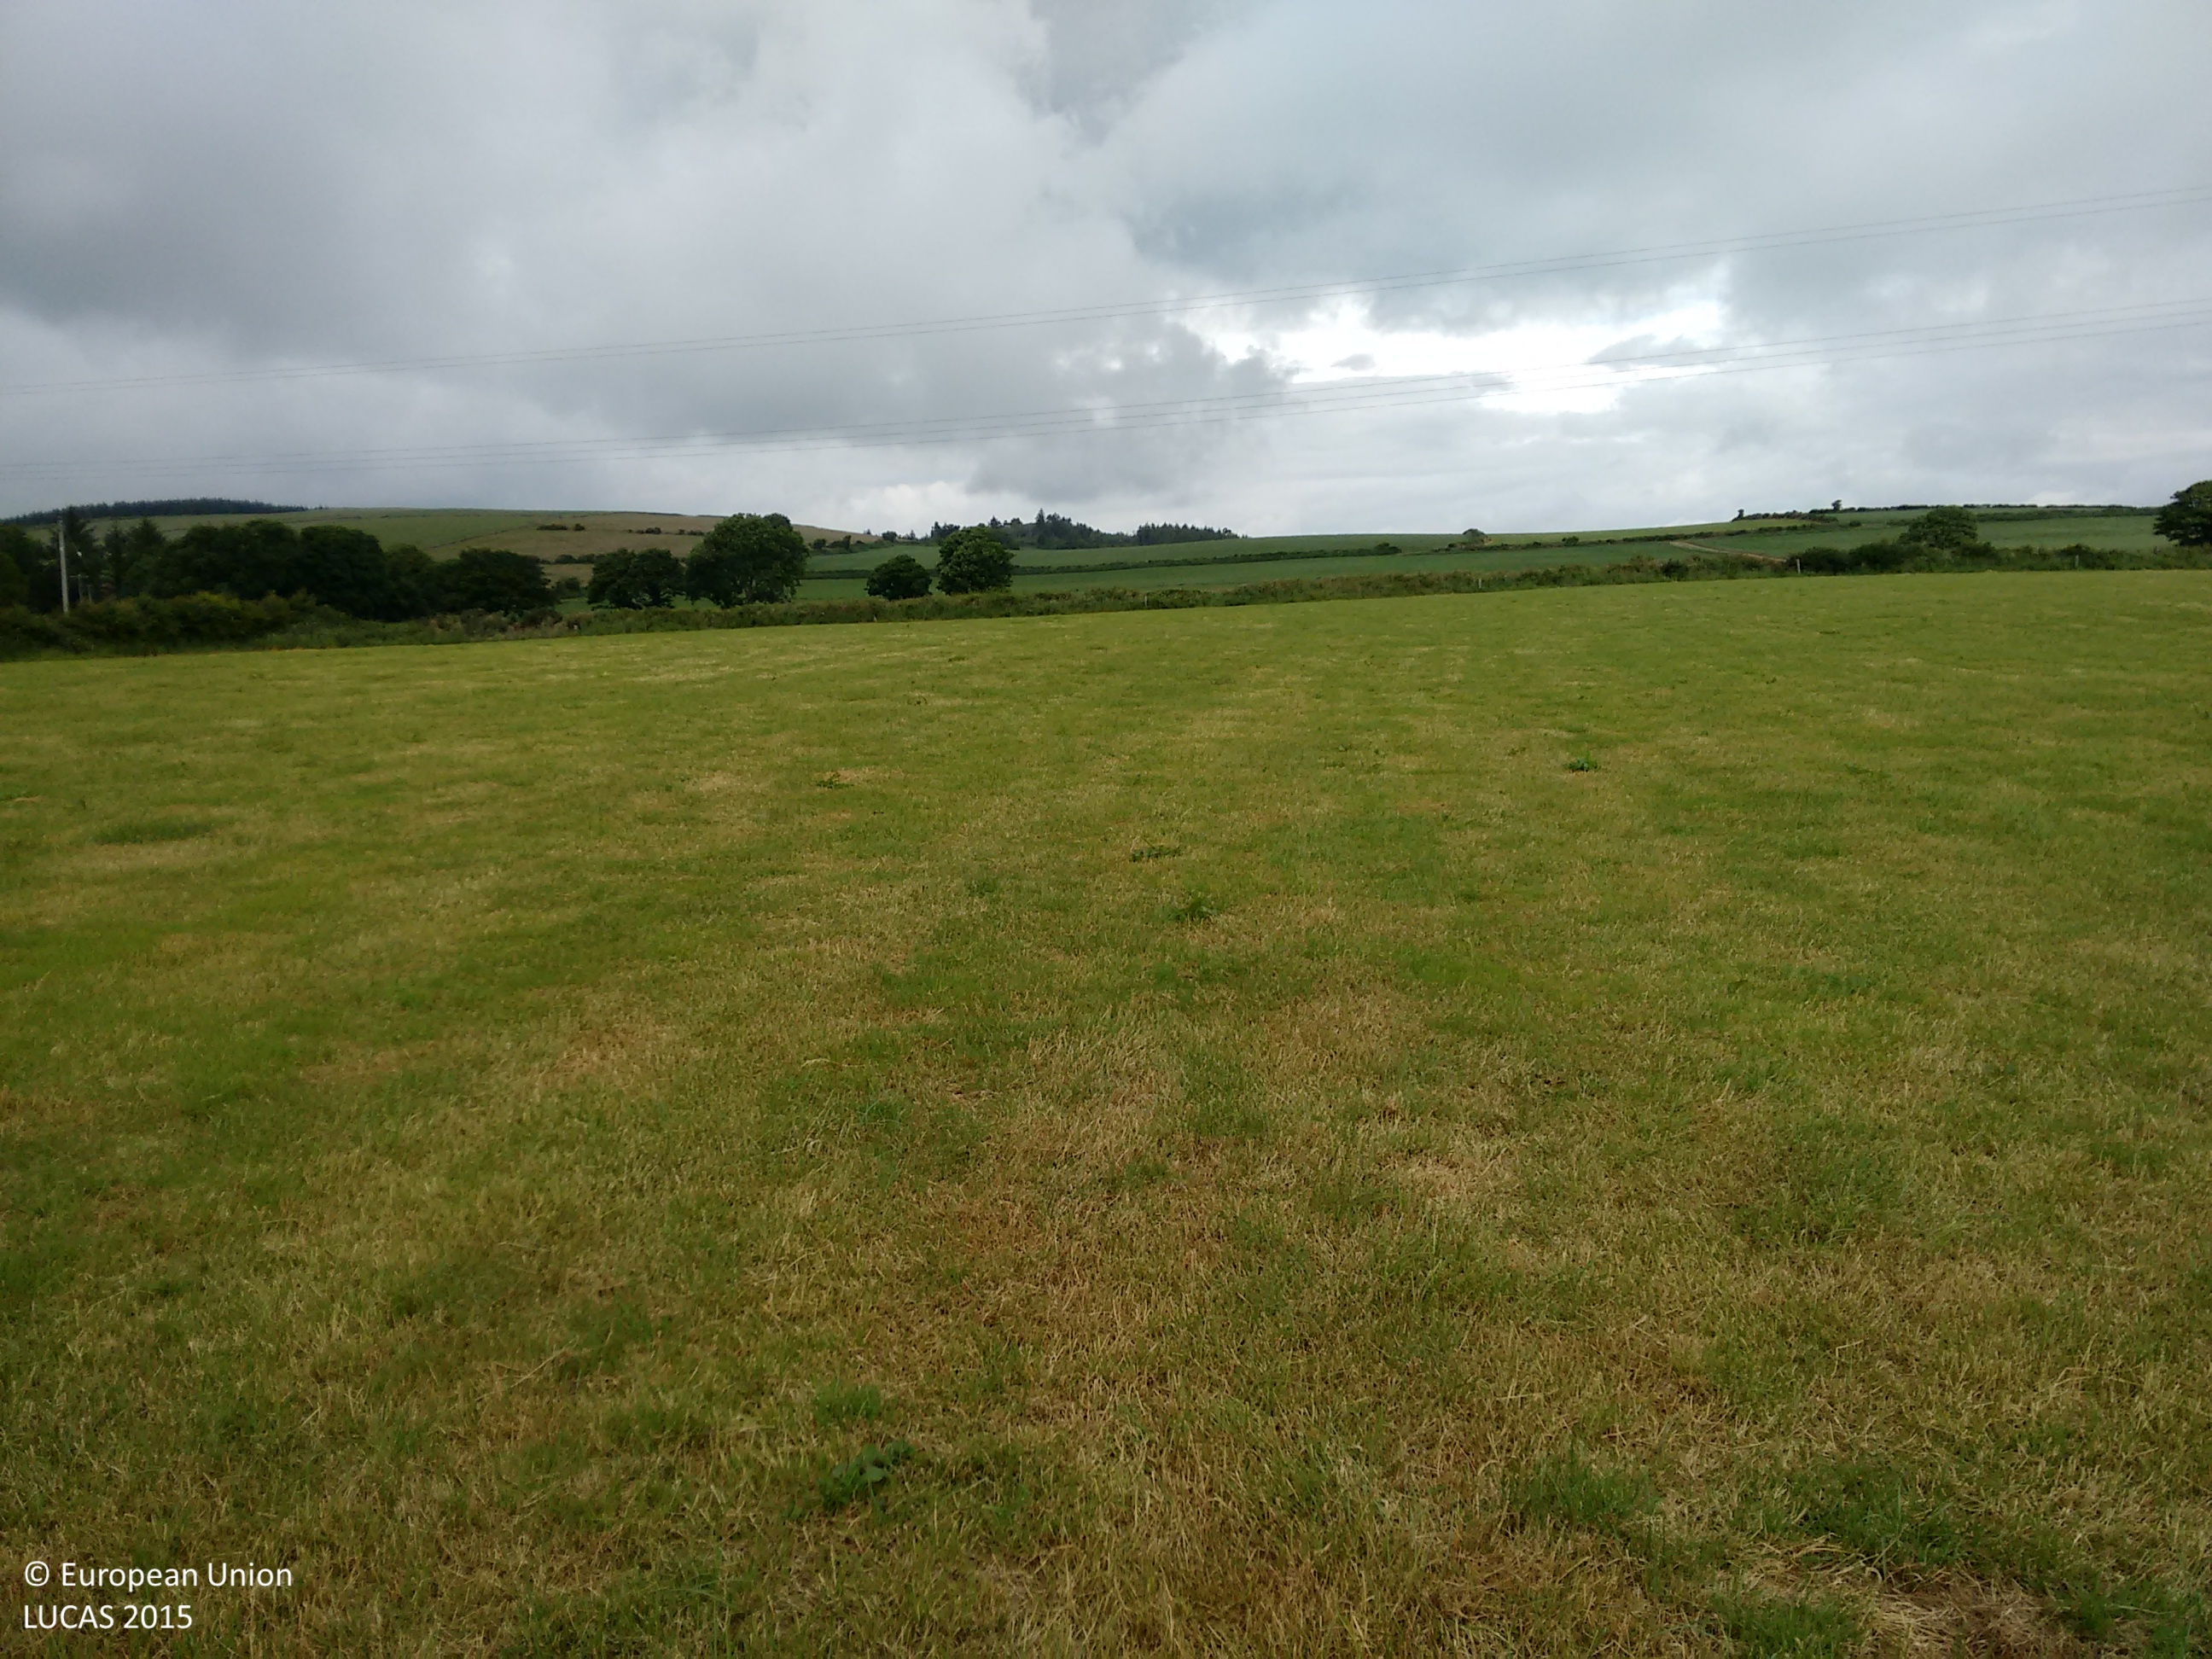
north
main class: Grassland
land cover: Grassland without tree/shrub cover
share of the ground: > 75 %
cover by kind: herbaceous plants 100 %
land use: Agriculture (excluding fallow land and kitchen gardens)
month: June
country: IE
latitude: 52.2521
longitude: -7.3060
